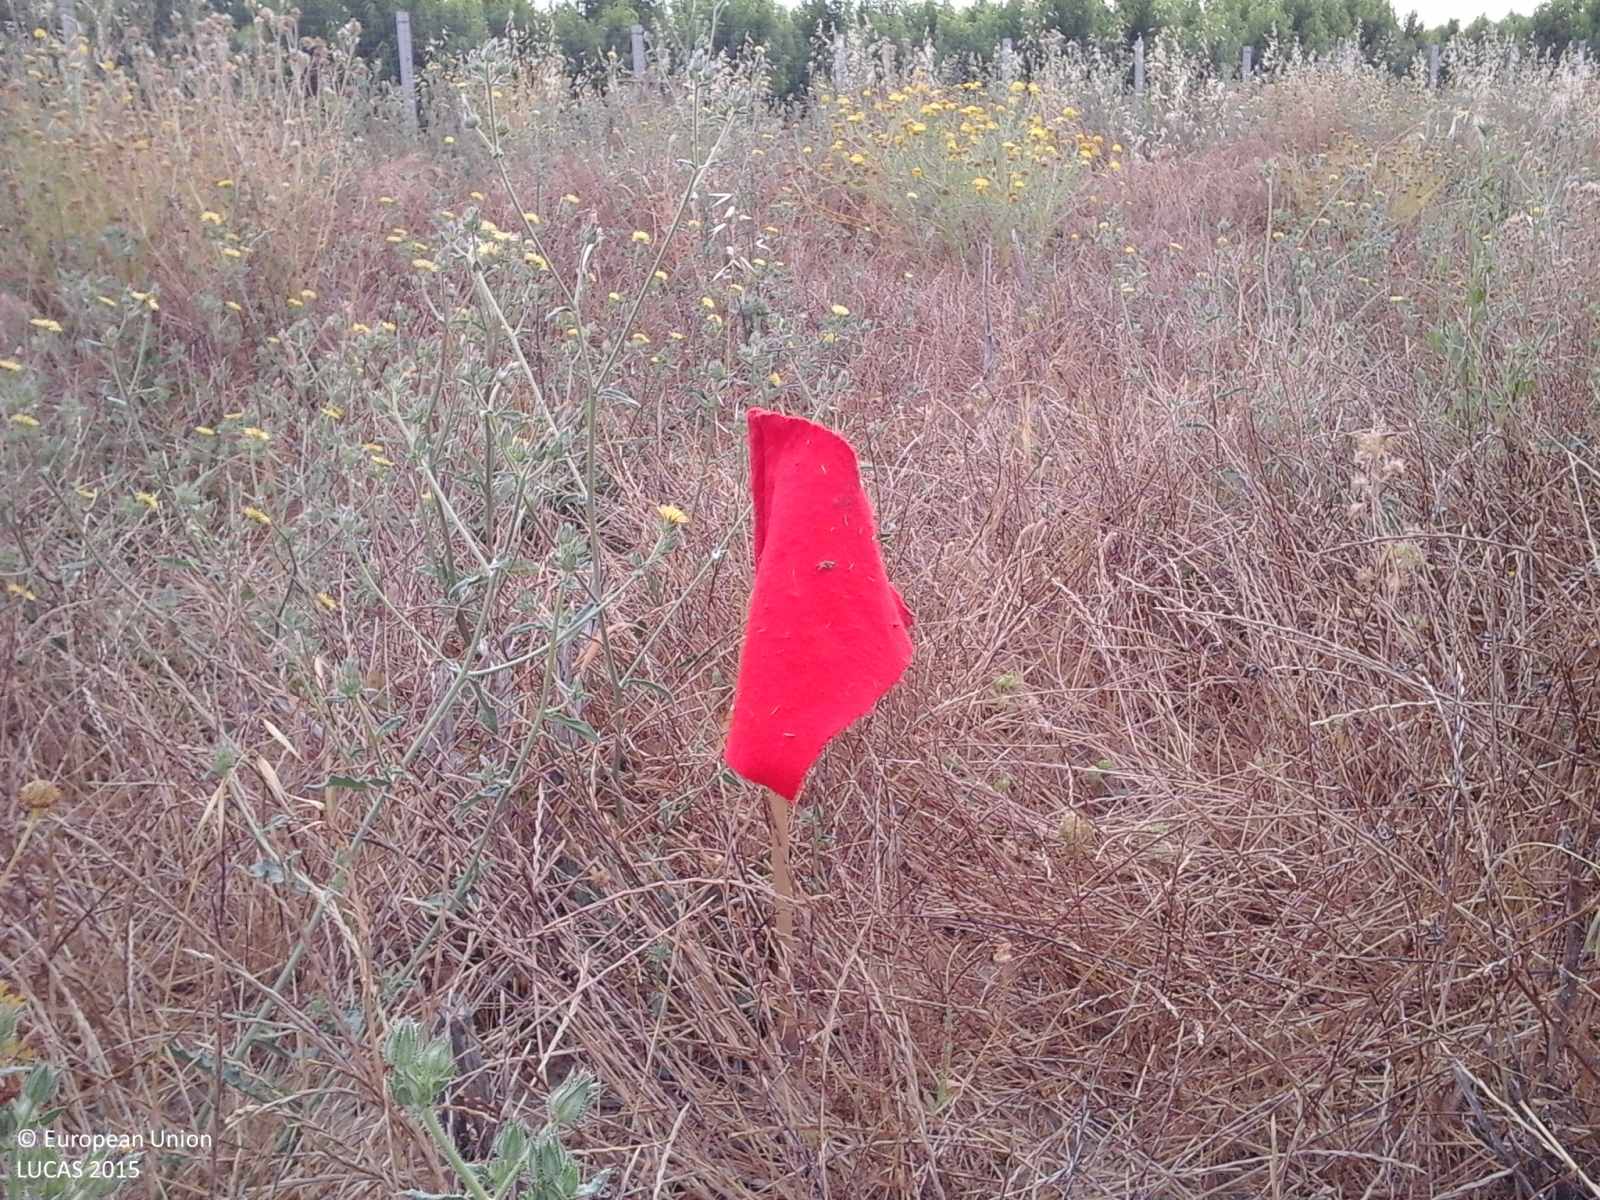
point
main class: Grassland
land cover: Spontaneously vegetated surfaces
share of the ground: > 75 %
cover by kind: herbaceous plants 100 %
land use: Fallow land
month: June
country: IT
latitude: 37.2374
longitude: 14.5754
